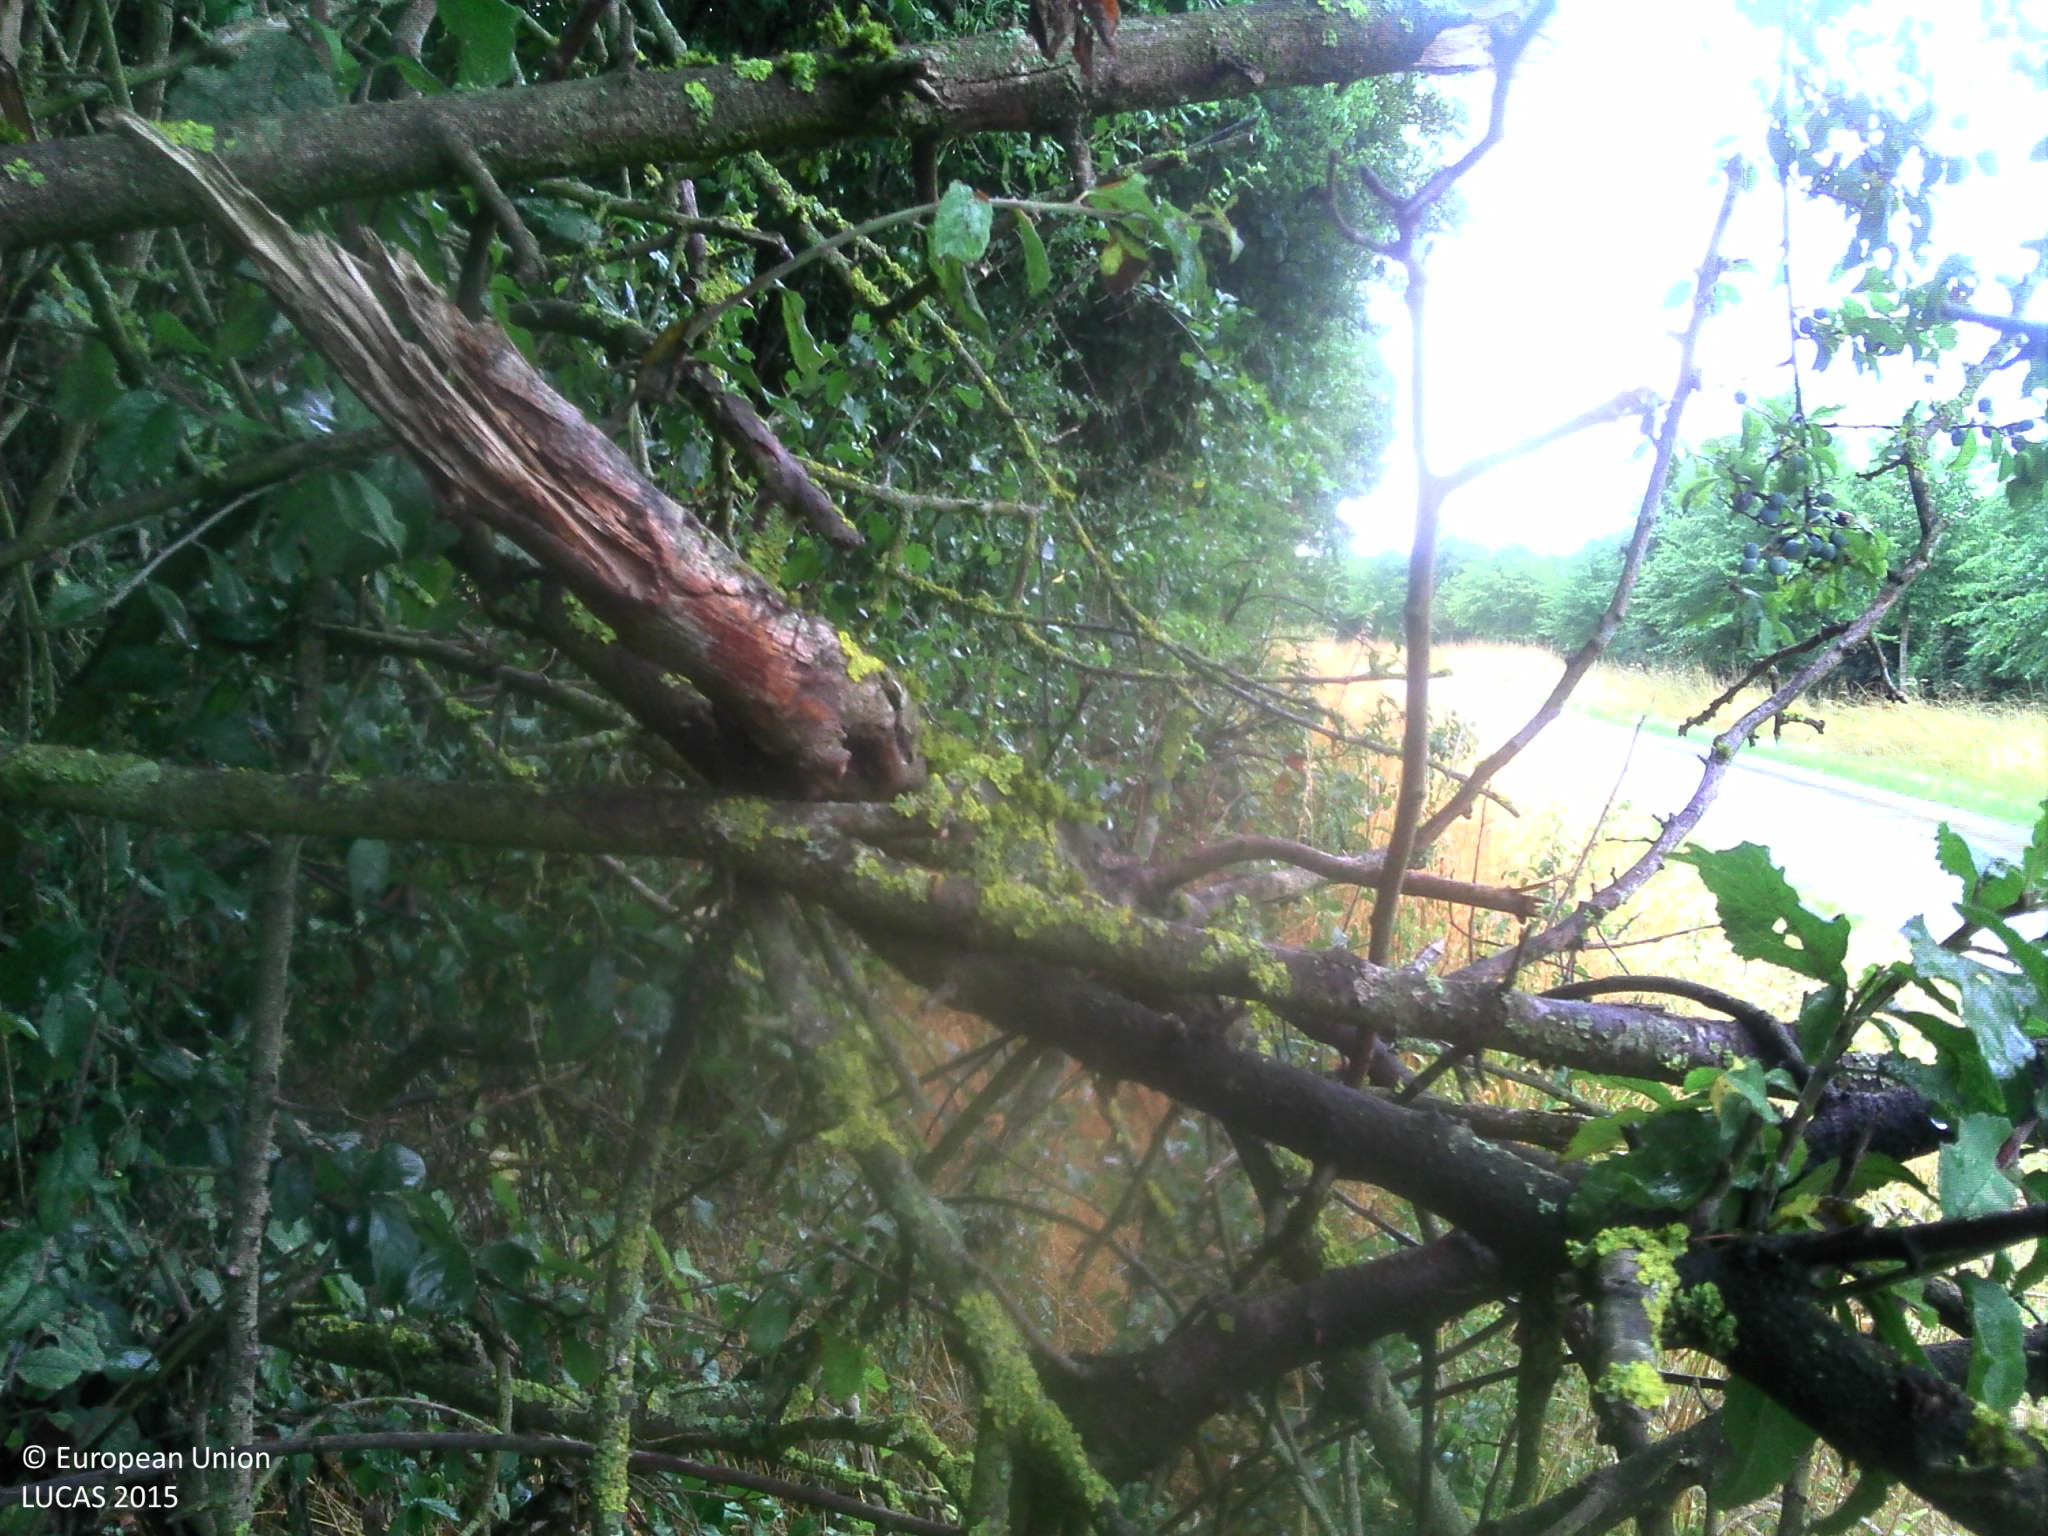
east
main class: Woodland
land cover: Broadleaved woodland
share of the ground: > 75 %
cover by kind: broadleaved forest trees 100 %
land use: Semi-natural and natural areas not in use
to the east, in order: Broadleaved woodland; Grass margins; Ditches and canals; Grass margins; Electric lines; Paved roads, cycling and walking lanes; Grass margins; Lines of trees; Abandoned hedges; Grassland without tree/shrub cover; Broadleaved woodland; Grassland without tree/shrub cover
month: July
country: BE
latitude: 50.1687
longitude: 4.6903
